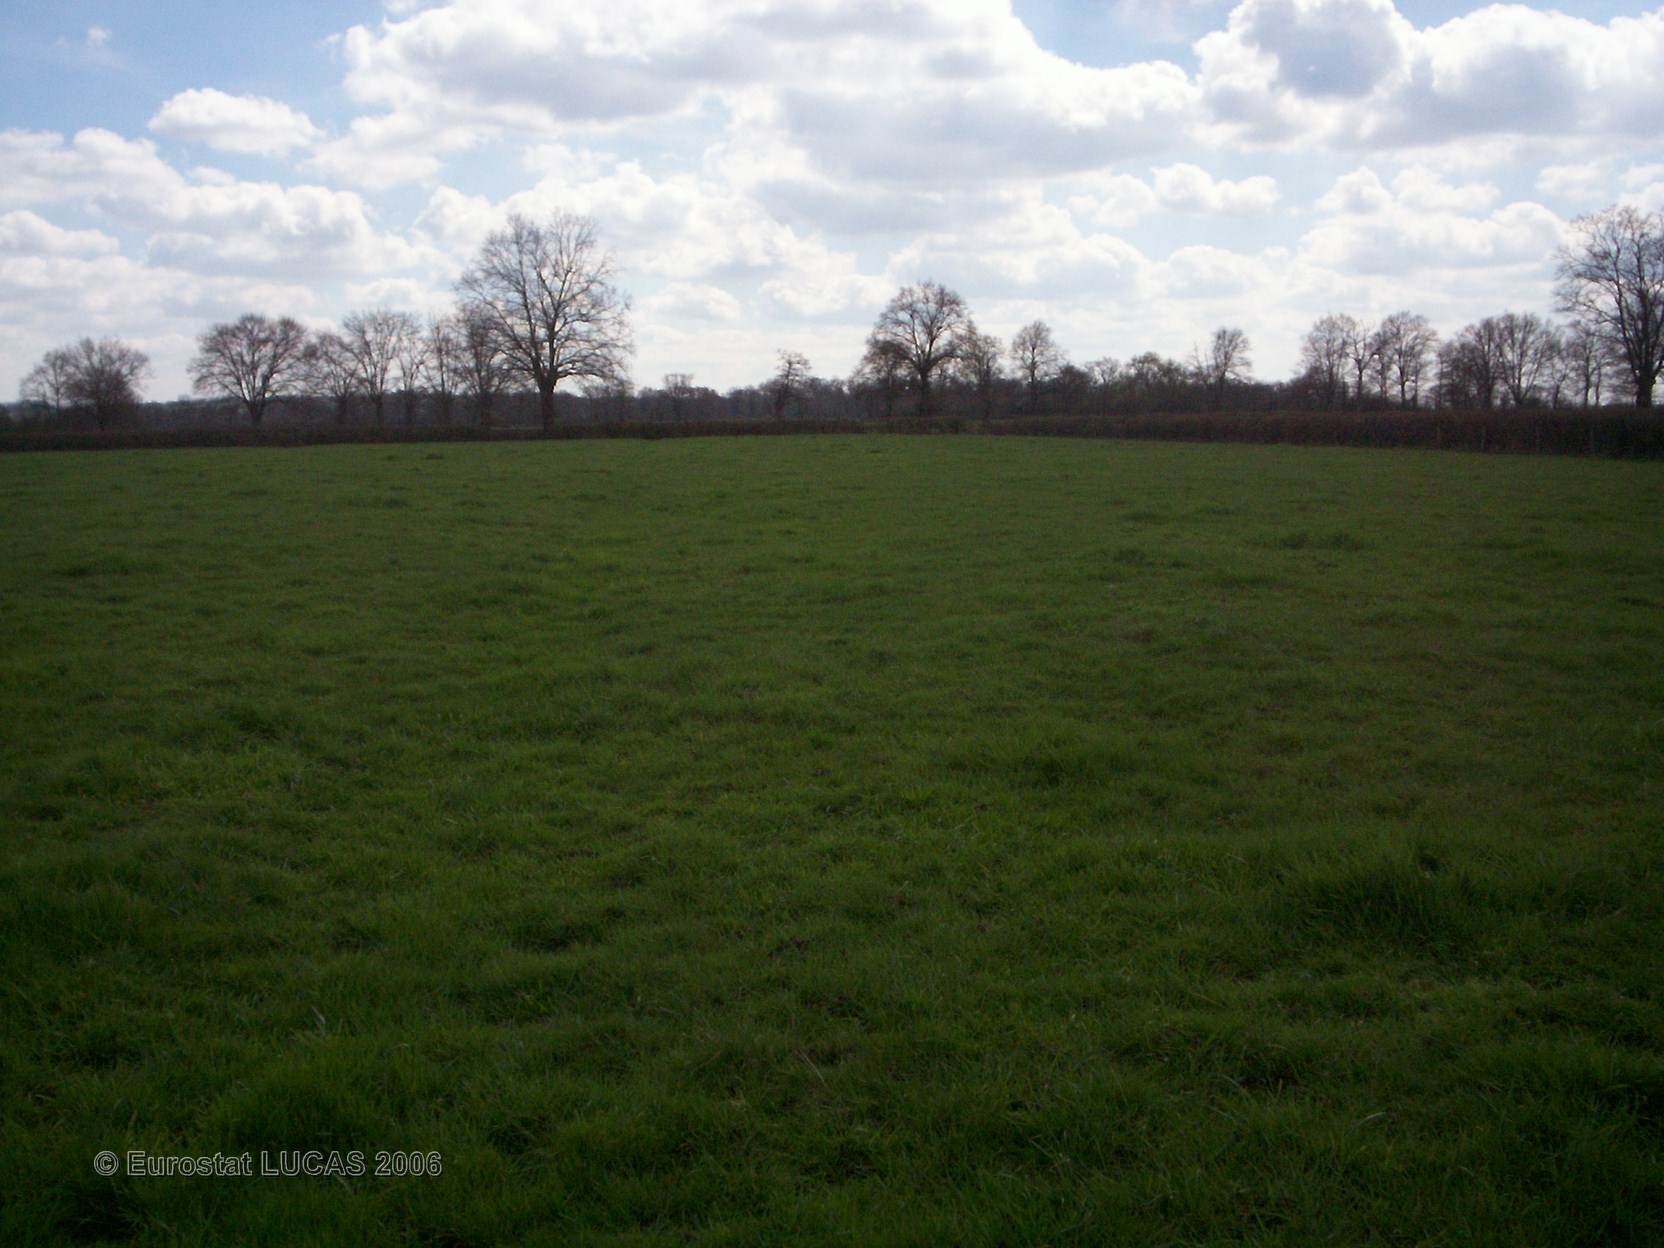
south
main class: Grassland
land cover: Grassland without tree/shrub cover
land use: Agriculture (excluding fallow land and kitchen gardens)
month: April
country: FR
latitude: 46.7948
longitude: 3.0660
